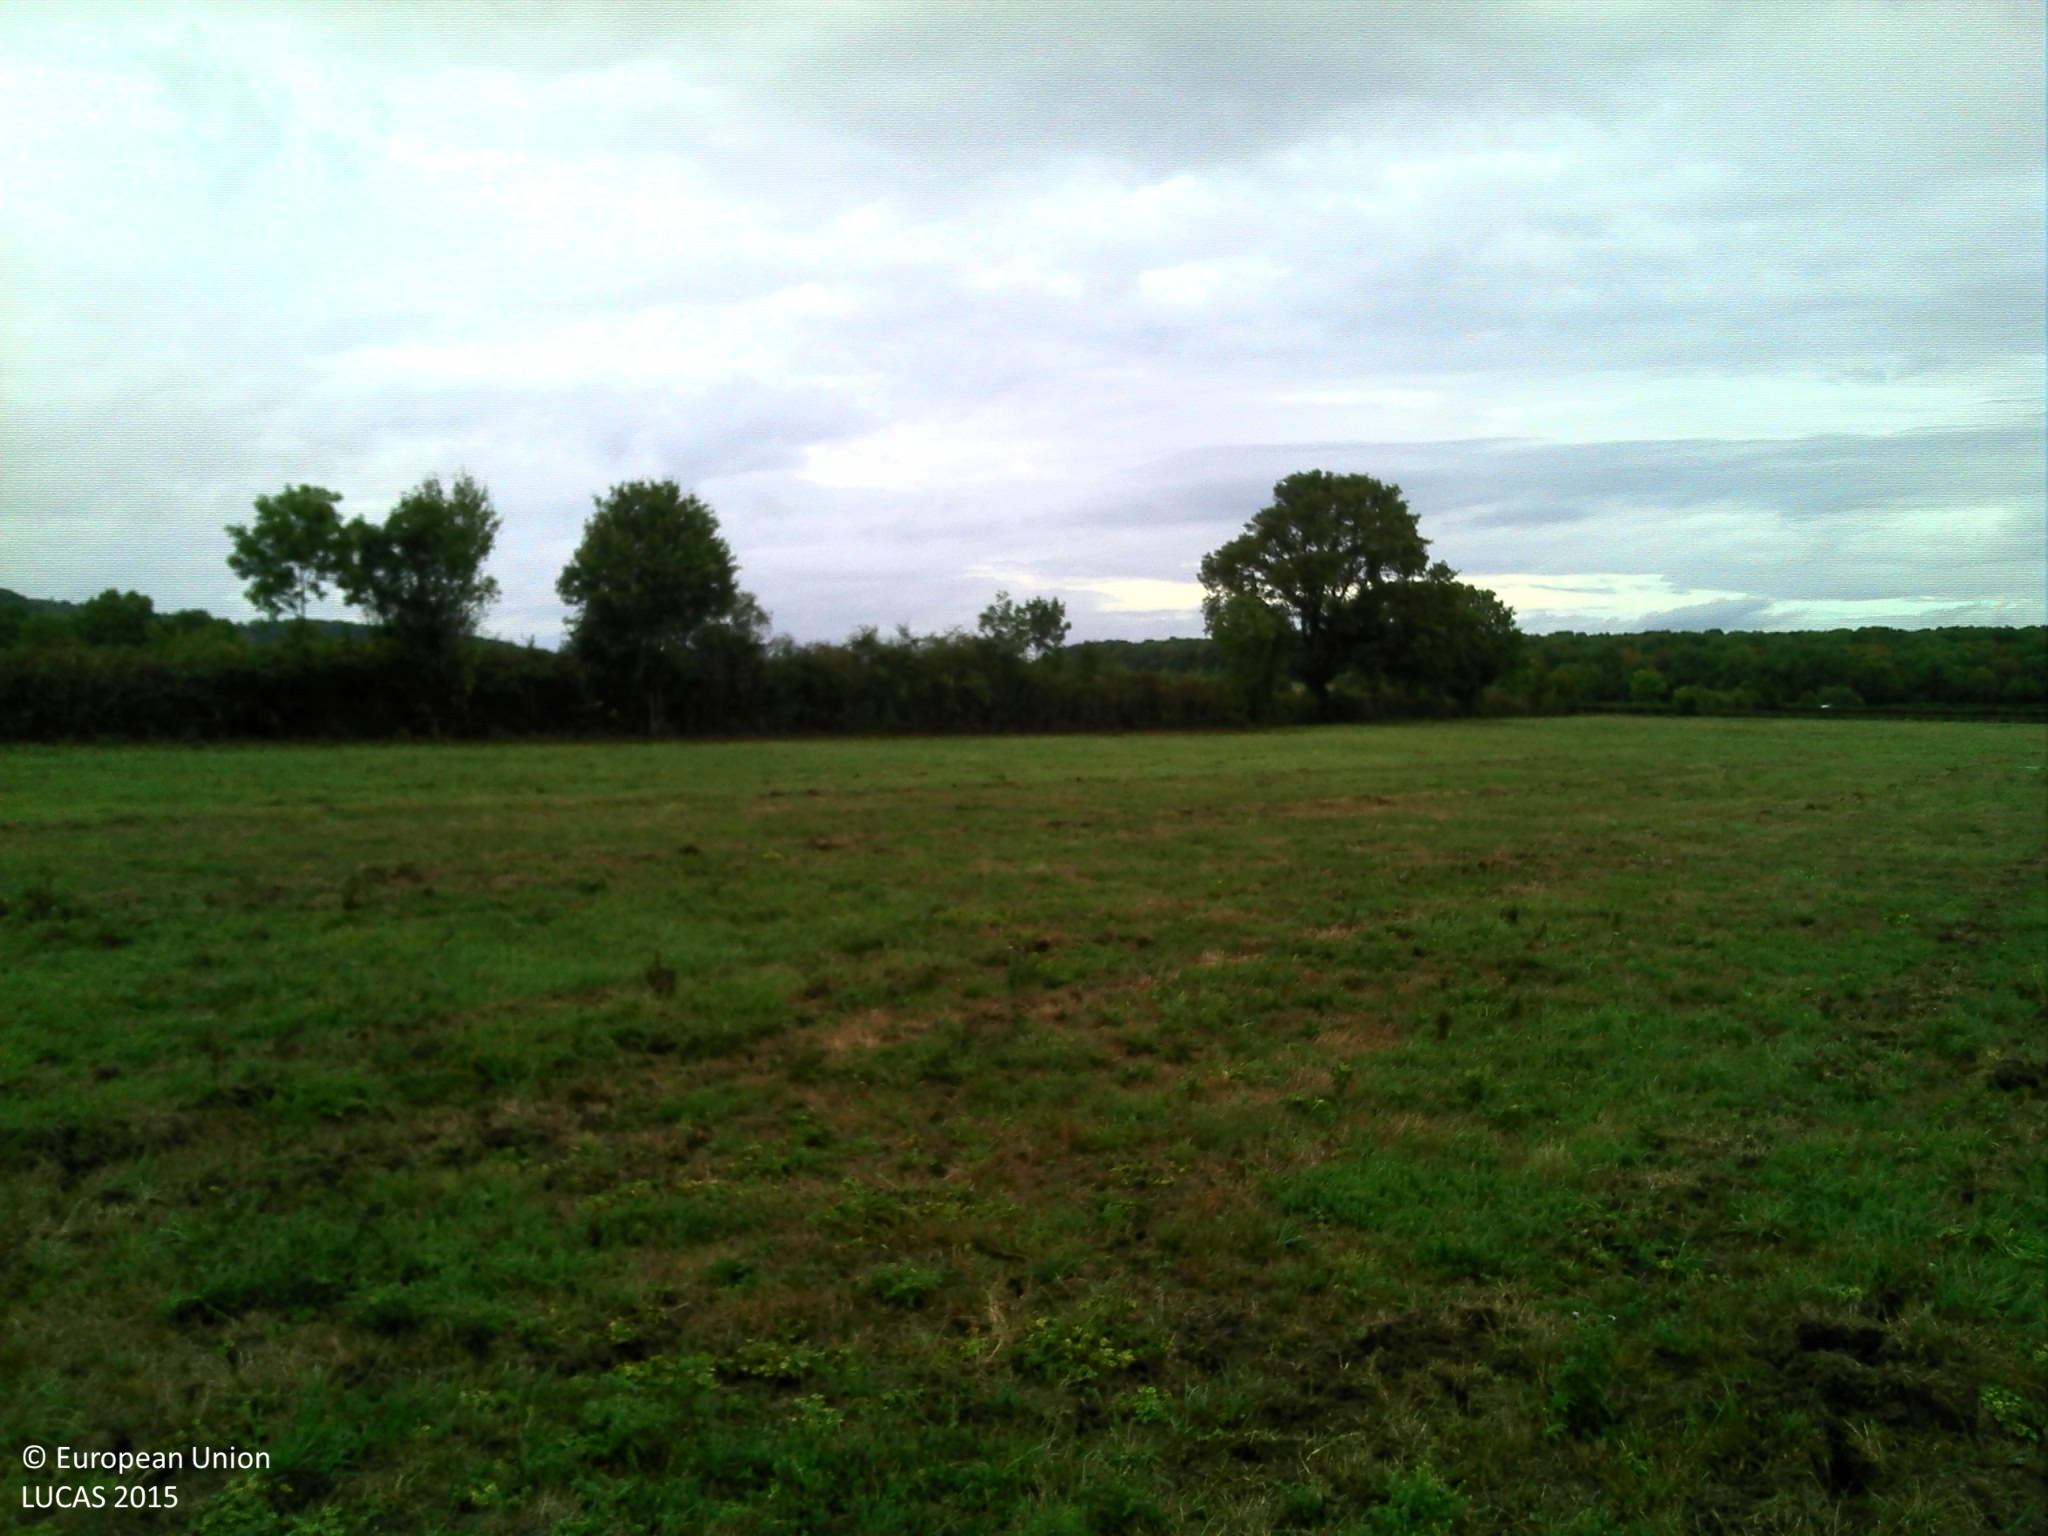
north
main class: Grassland
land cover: Grassland without tree/shrub cover
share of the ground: > 75 %
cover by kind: herbaceous plants 100 %
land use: Agriculture (excluding fallow land and kitchen gardens)
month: September
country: FR
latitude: 47.3582
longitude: 4.3722
